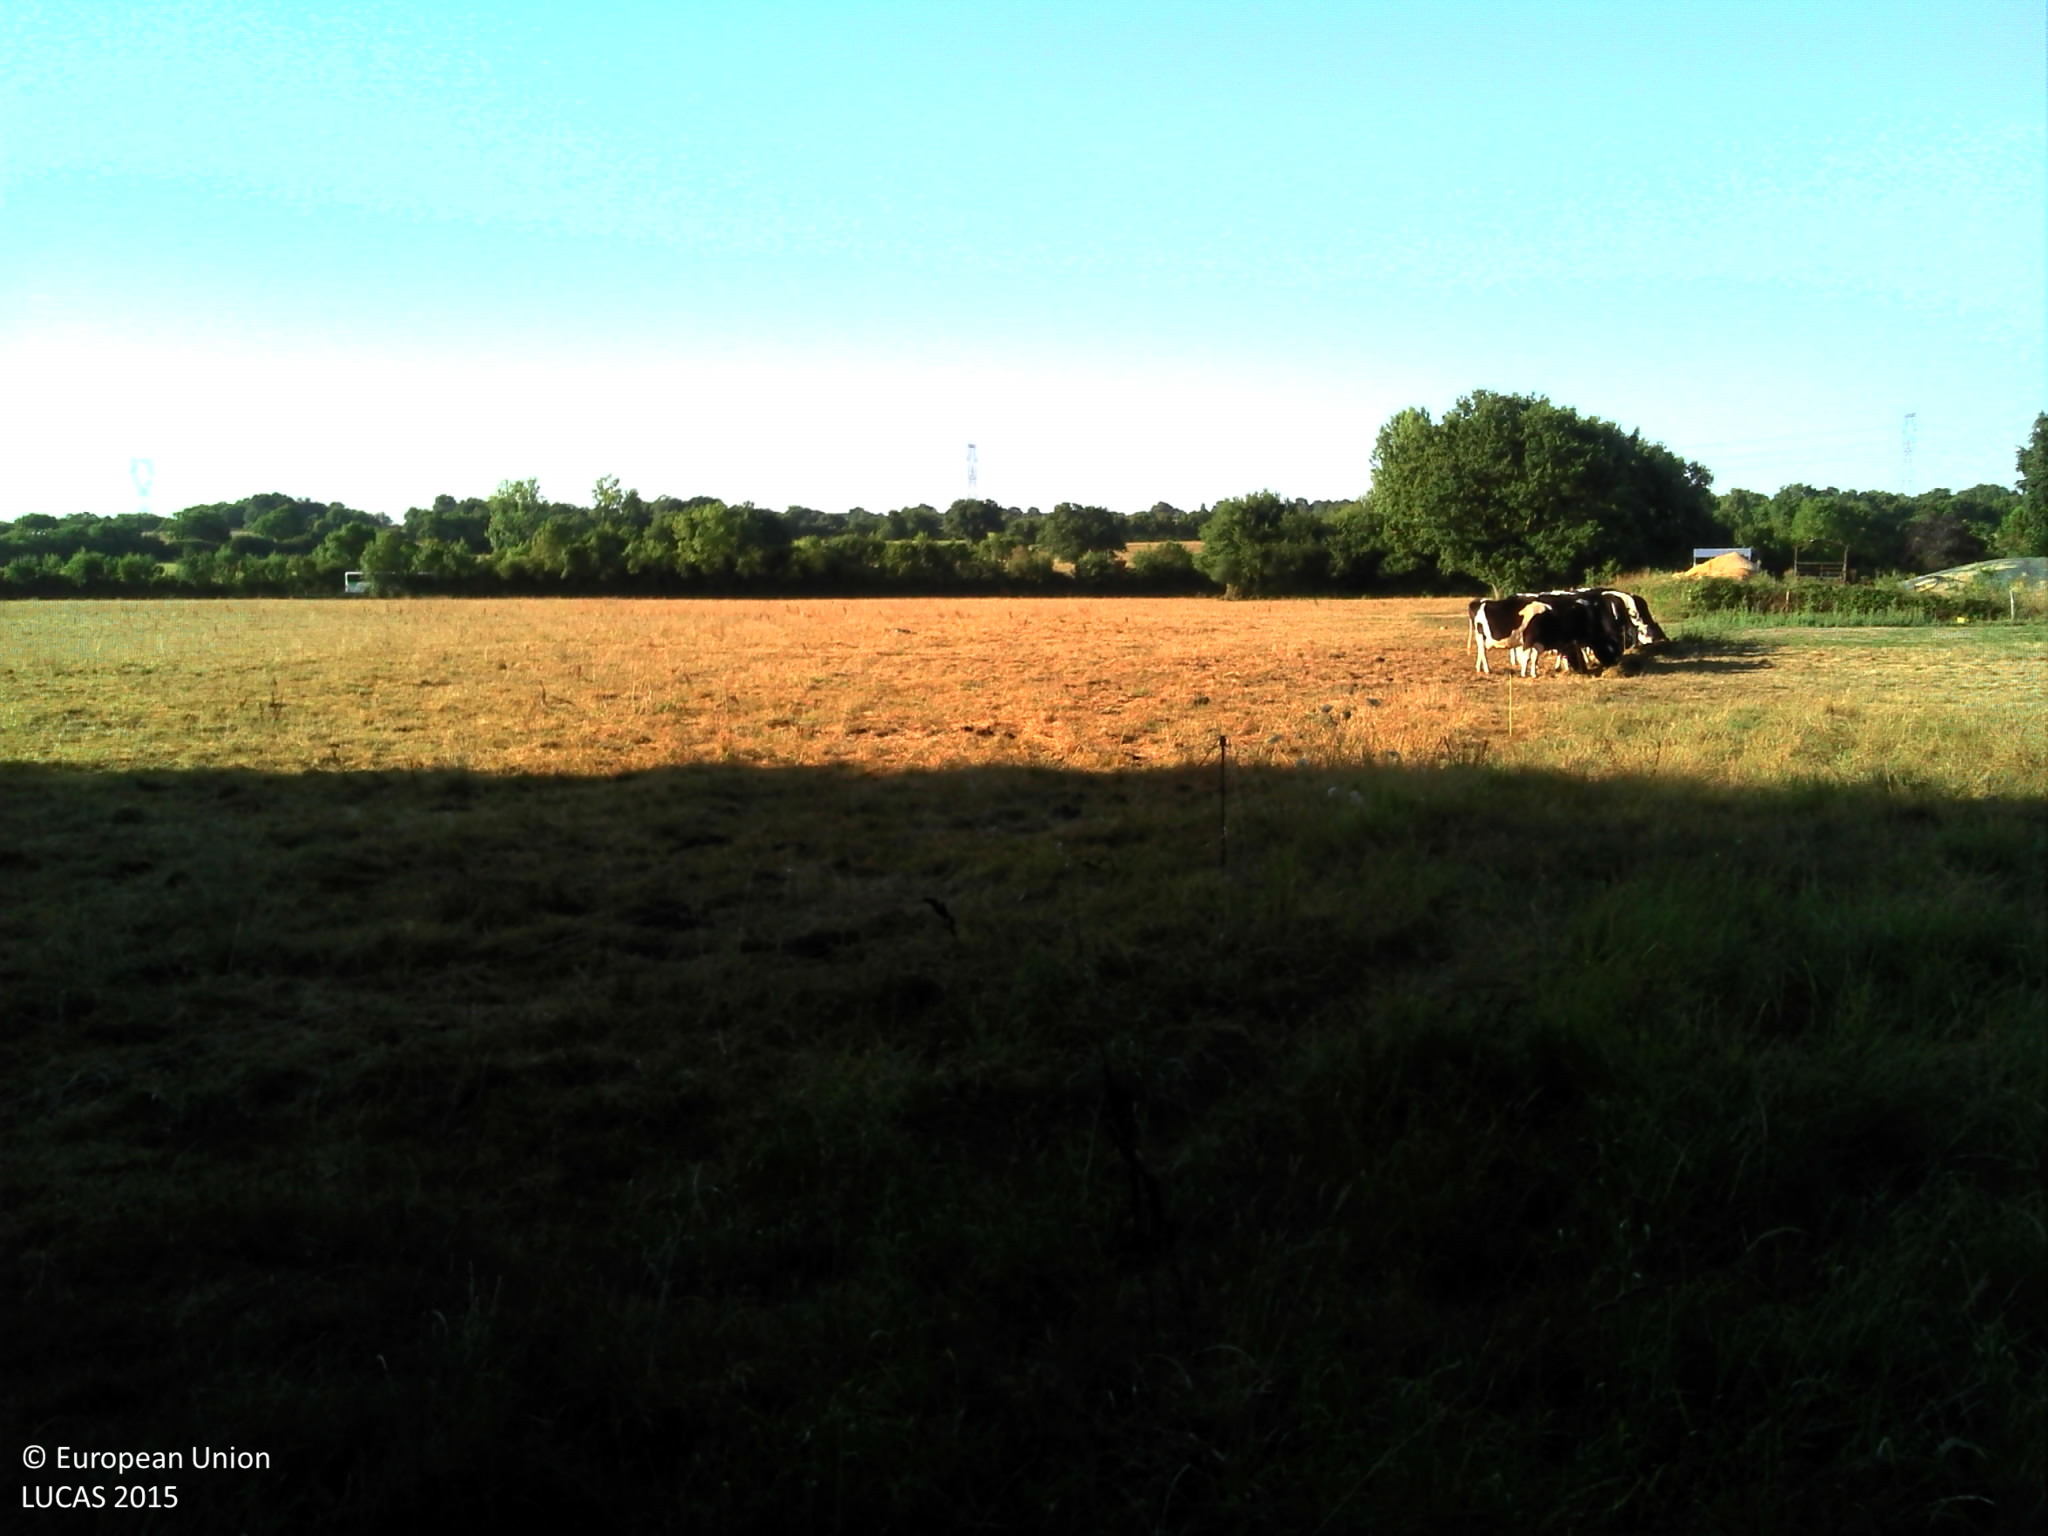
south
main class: Grassland
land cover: Grassland without tree/shrub cover
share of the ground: > 75 %
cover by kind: herbaceous plants 100 %
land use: Agriculture (excluding fallow land and kitchen gardens)
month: August
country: FR
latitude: 47.4309
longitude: -1.5644
